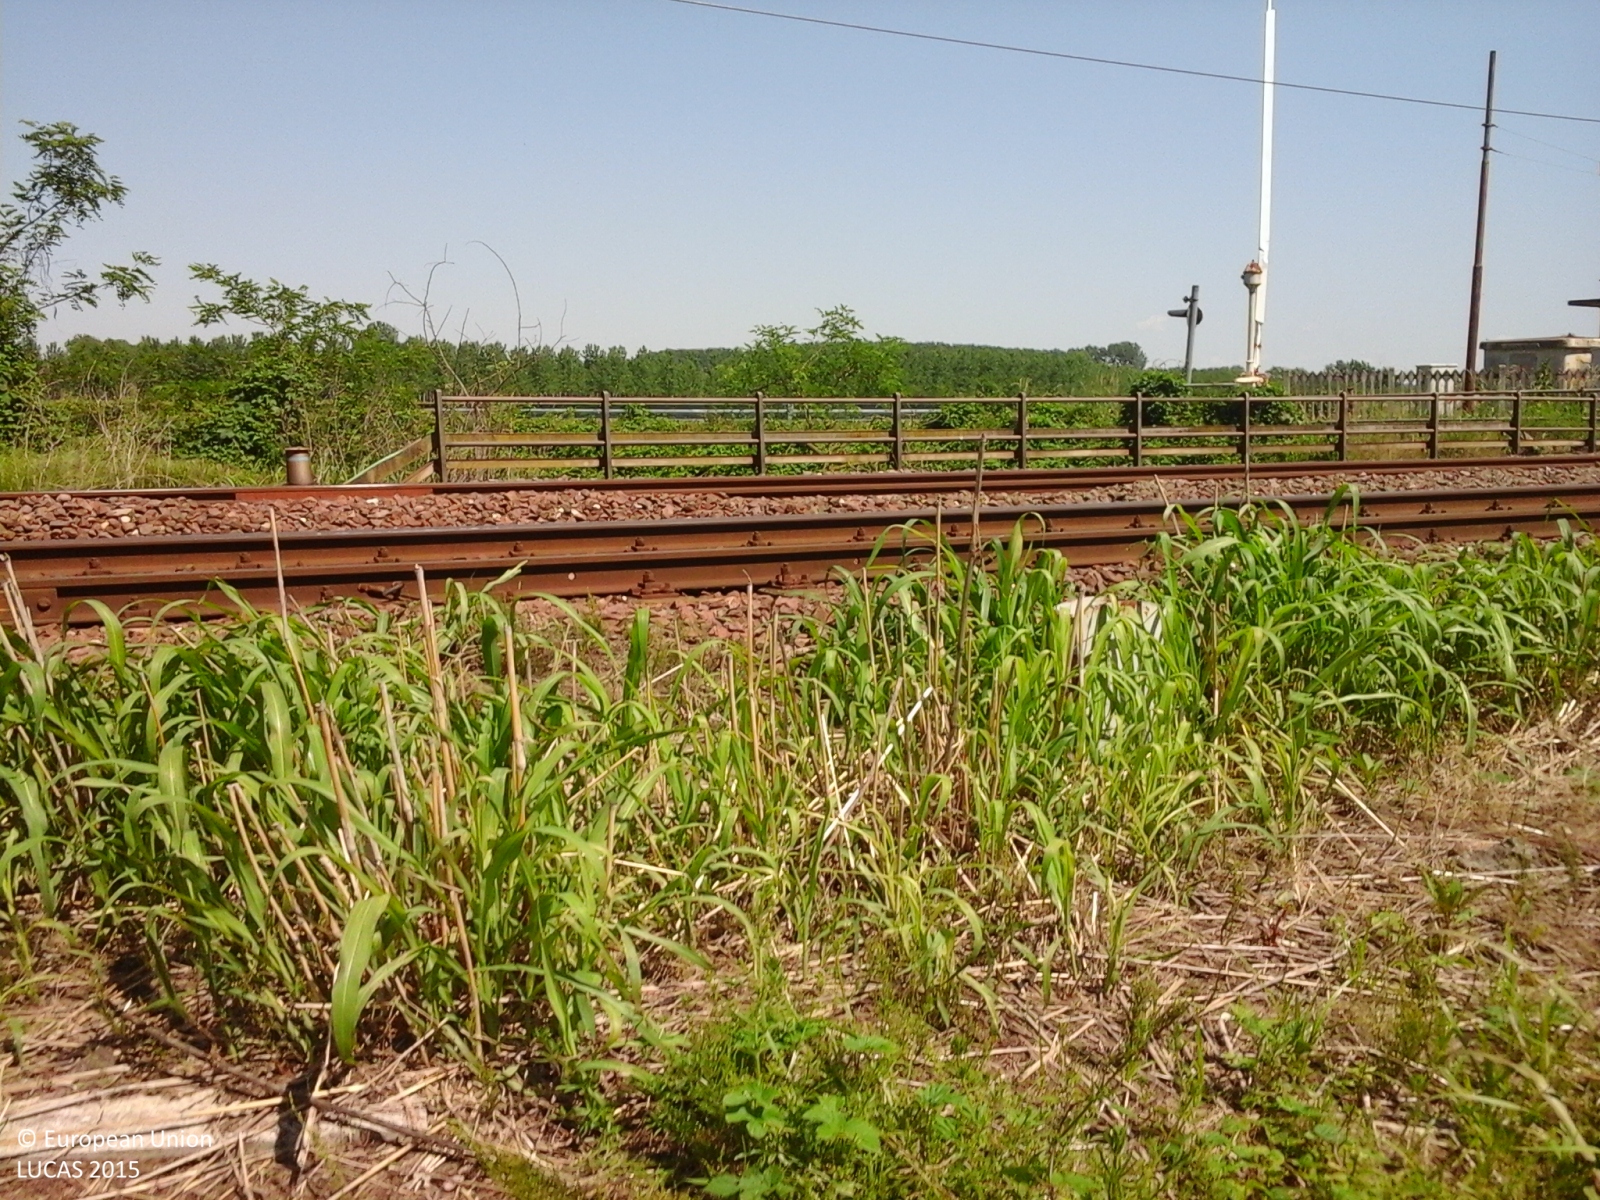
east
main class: Cropland
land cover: Maize
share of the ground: 50 - 75 %
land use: Agriculture (excluding fallow land and kitchen gardens)
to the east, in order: Maize; Grass margins; Electric lines; Railways; Broadleaved woodland; Inland fresh running water; Shruby margins; Paved roads, cycling and walking lanes; Grass margins; Ditches and canals; Grass margins; Rice; Ditches and canals; Rice; Ditches and canals; Rice; Ditches and canals; Rice
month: May
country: IT
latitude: 45.2983
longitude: 8.7143
